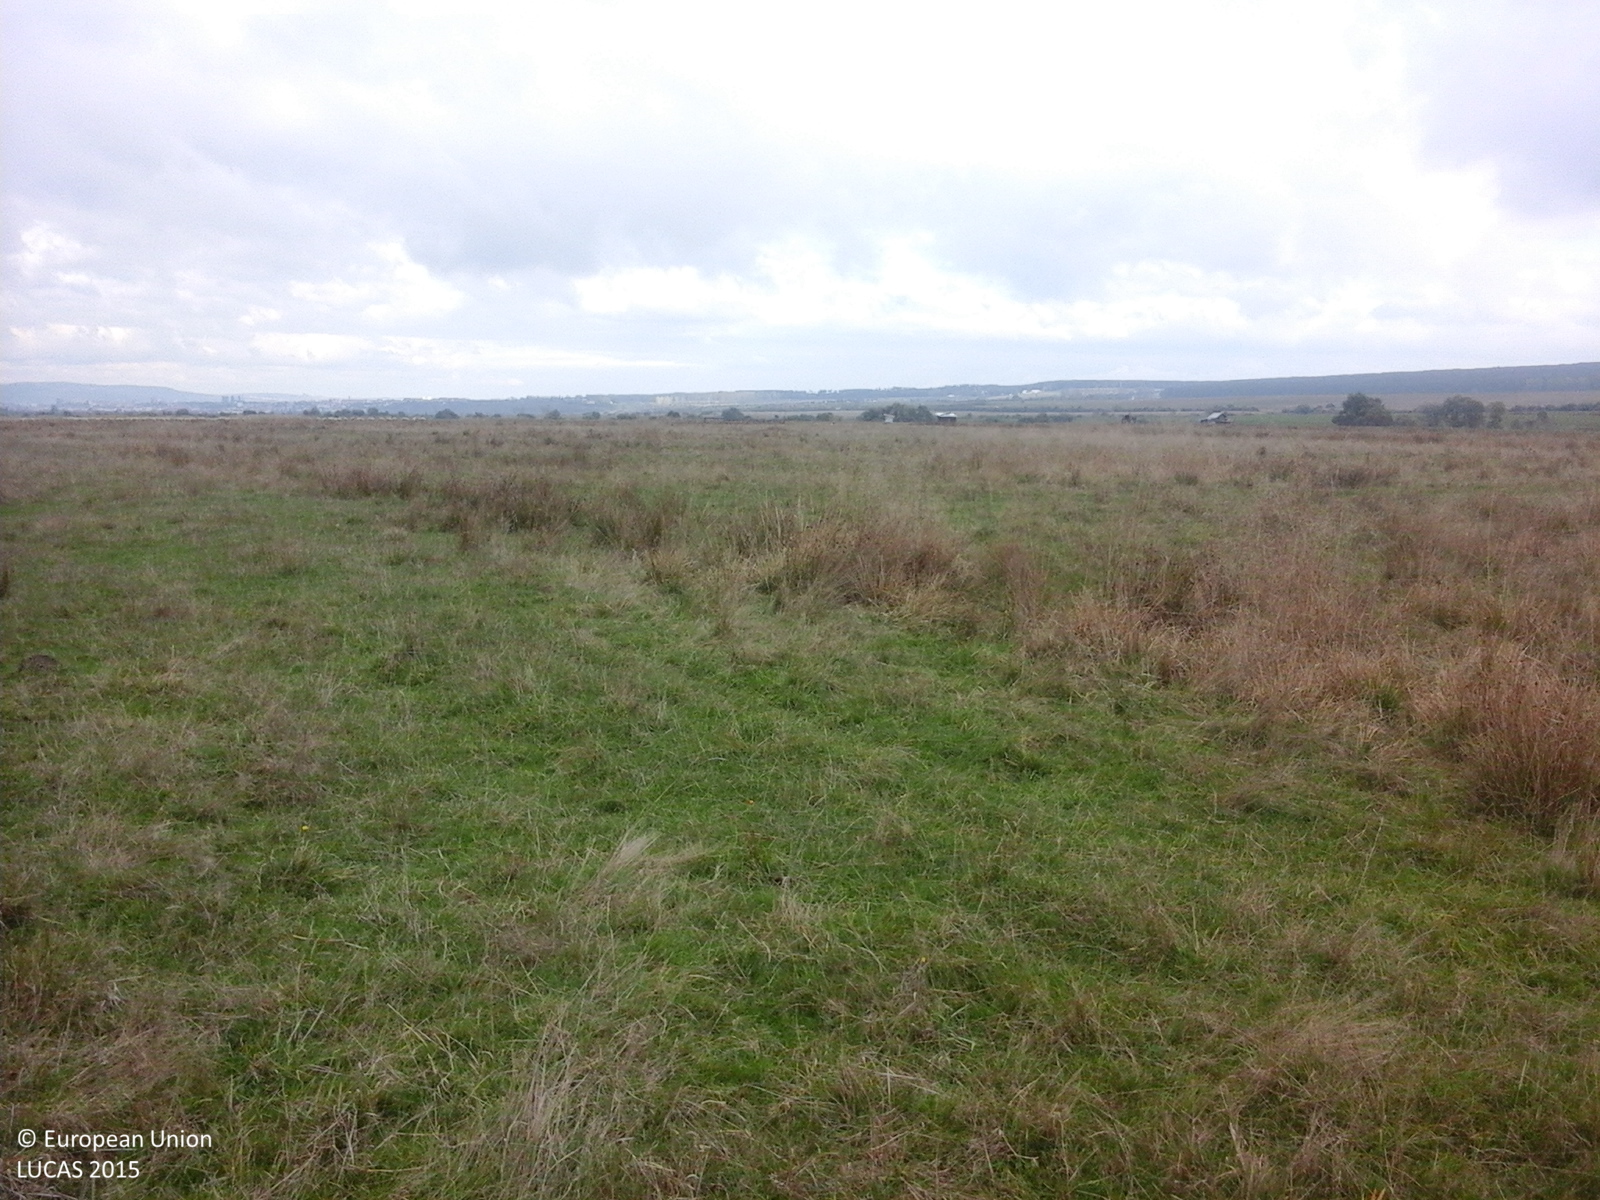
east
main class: Grassland
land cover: Grassland without tree/shrub cover
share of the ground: > 75 %
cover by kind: herbaceous plants 100 %
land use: Agriculture (excluding fallow land and kitchen gardens)
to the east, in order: Grassland without tree/shrub cover
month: October
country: RO
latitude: 45.7655
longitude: 24.0496
